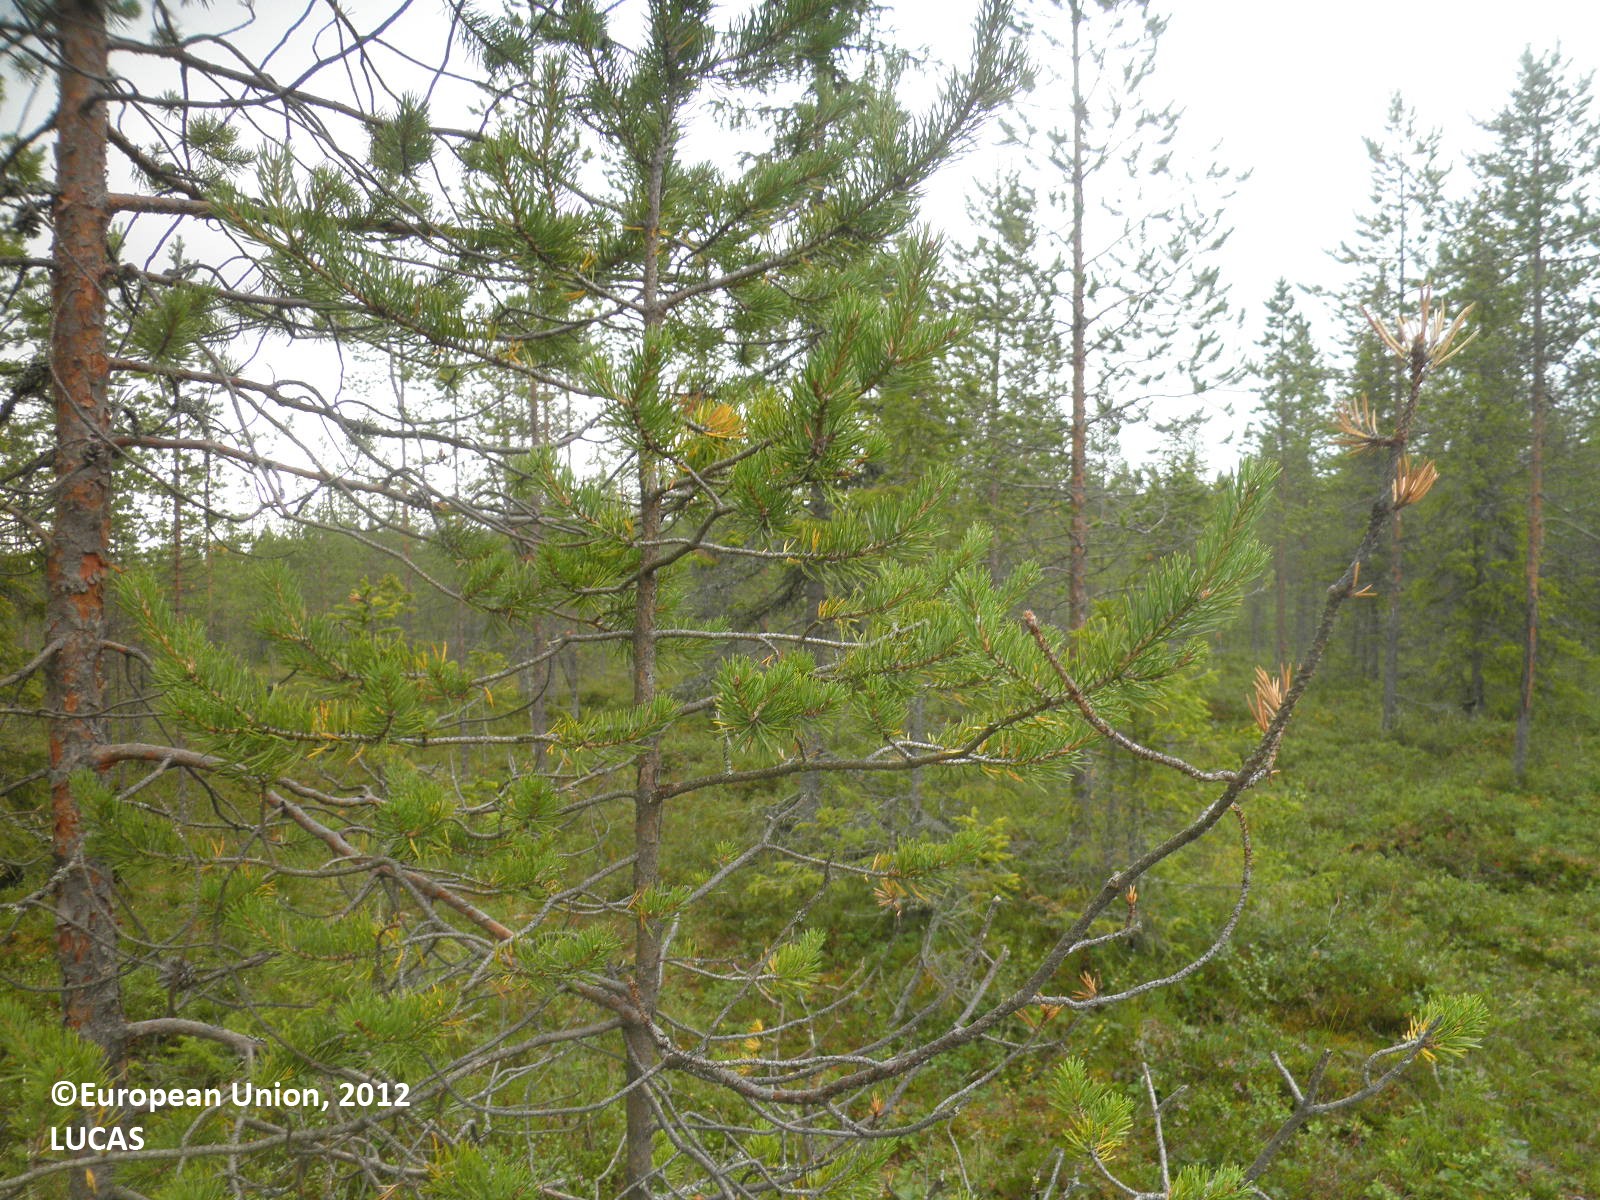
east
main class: Woodland
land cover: Pine dominated coniferous woodland
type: boreal forest
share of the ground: 25 - 50 %
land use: Forestry
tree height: > 5 m
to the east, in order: Pine dominated coniferous woodland; Ditches and canals; Pine dominated coniferous woodland; Pine dominated mixed woodland; Ditches and canals; Spruce dominated mixed woodland; Ditches and canals; Pine dominated coniferous woodland; Rivers and streams; Tracks; Pine dominated mixed woodland; Tracks
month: July
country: FI
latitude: 66.9426
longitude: 28.8437
